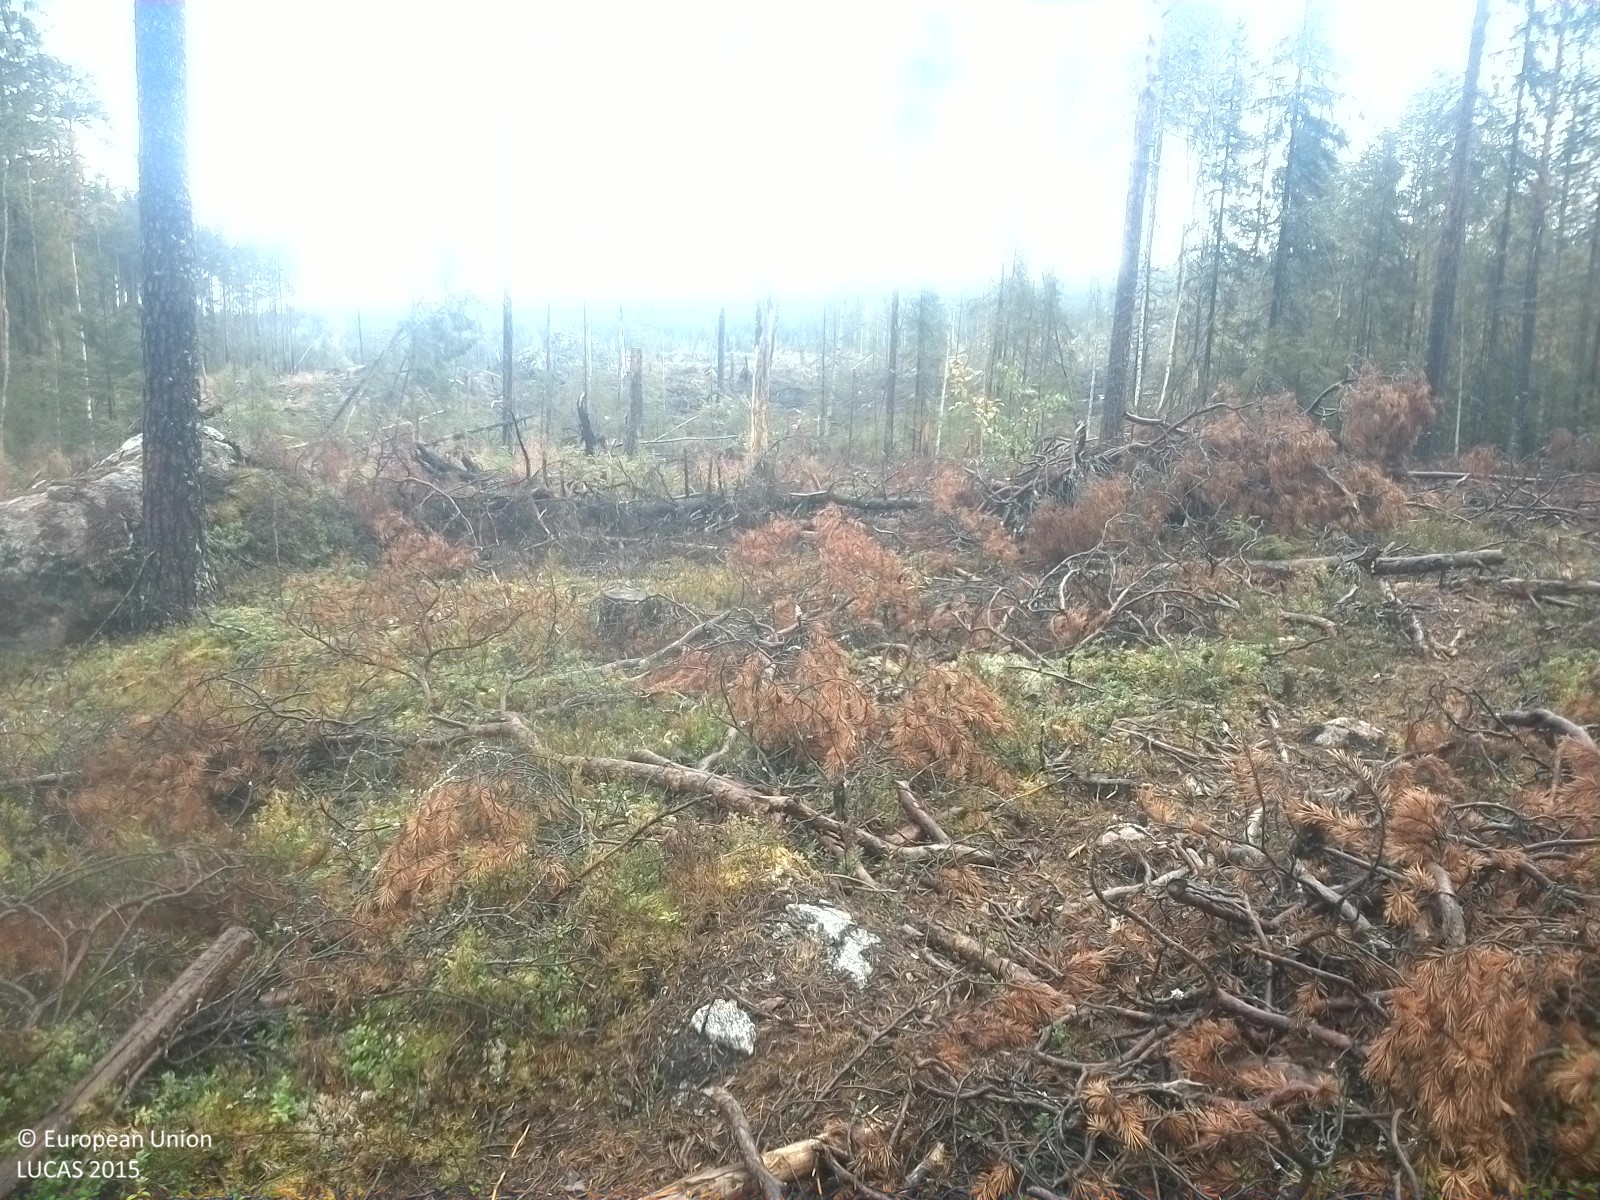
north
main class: Grassland
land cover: Grassland with sparse tree/shrub cover
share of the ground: > 75 %
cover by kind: herbaceous plants 95 %, broadleaved forest trees 5 %
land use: Residential
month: September
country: SE
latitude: 62.1617
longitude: 15.6821
